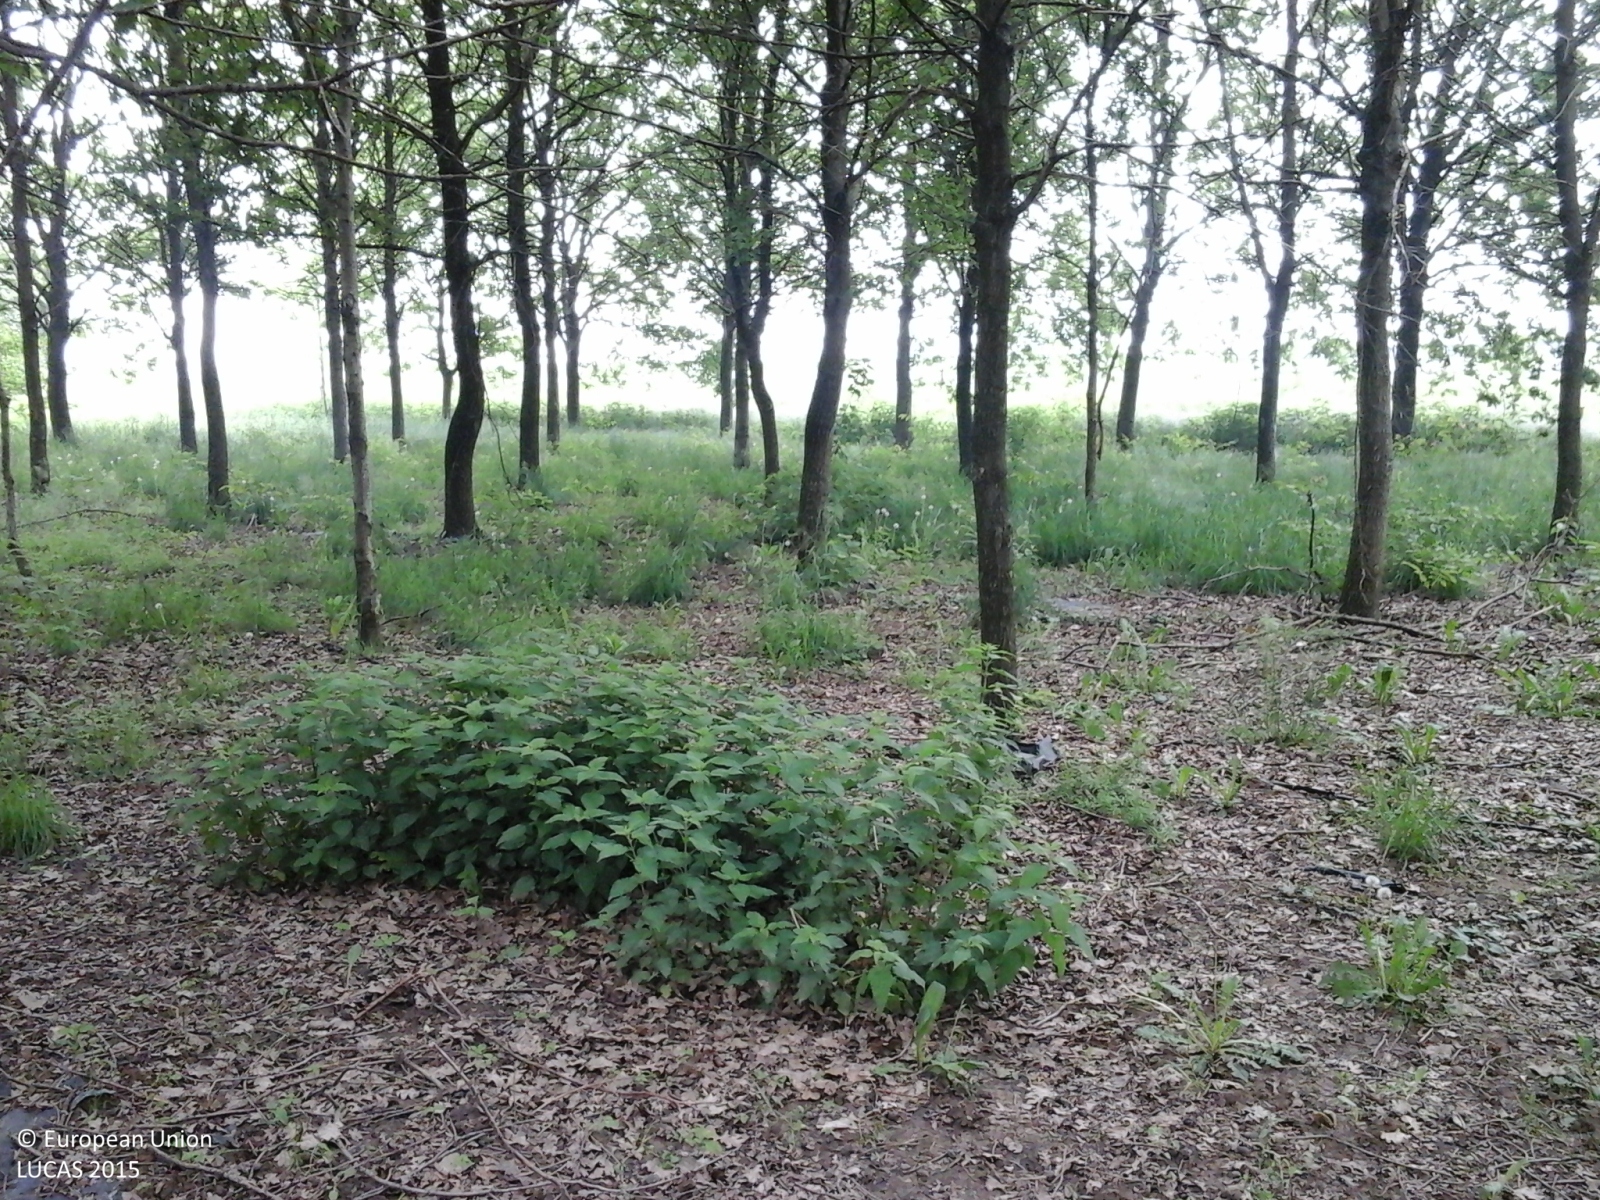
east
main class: Woodland
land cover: Broadleaved woodland
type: mesophytic deciduous forest
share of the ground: > 75 %
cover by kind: broadleaved forest trees 100 %
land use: Forestry
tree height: > 5 m
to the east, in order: Broadleaved woodland; Grass margins; Ditches and canals; Grass margins; Paved roads, cycling and walking lanes; Grass margins; Ditches and canals; Grass margins; Paved roads, cycling and walking lanes; Grass margins; Ditches and canals; Grass margins; Paved roads, cycling and walking lanes; Grass margins; Fences; Grass margins; Ditches and canals; Tracks; Lucerne; Ditches and canals; Lucerne
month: May
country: IT
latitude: 45.1259
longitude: 10.0634
